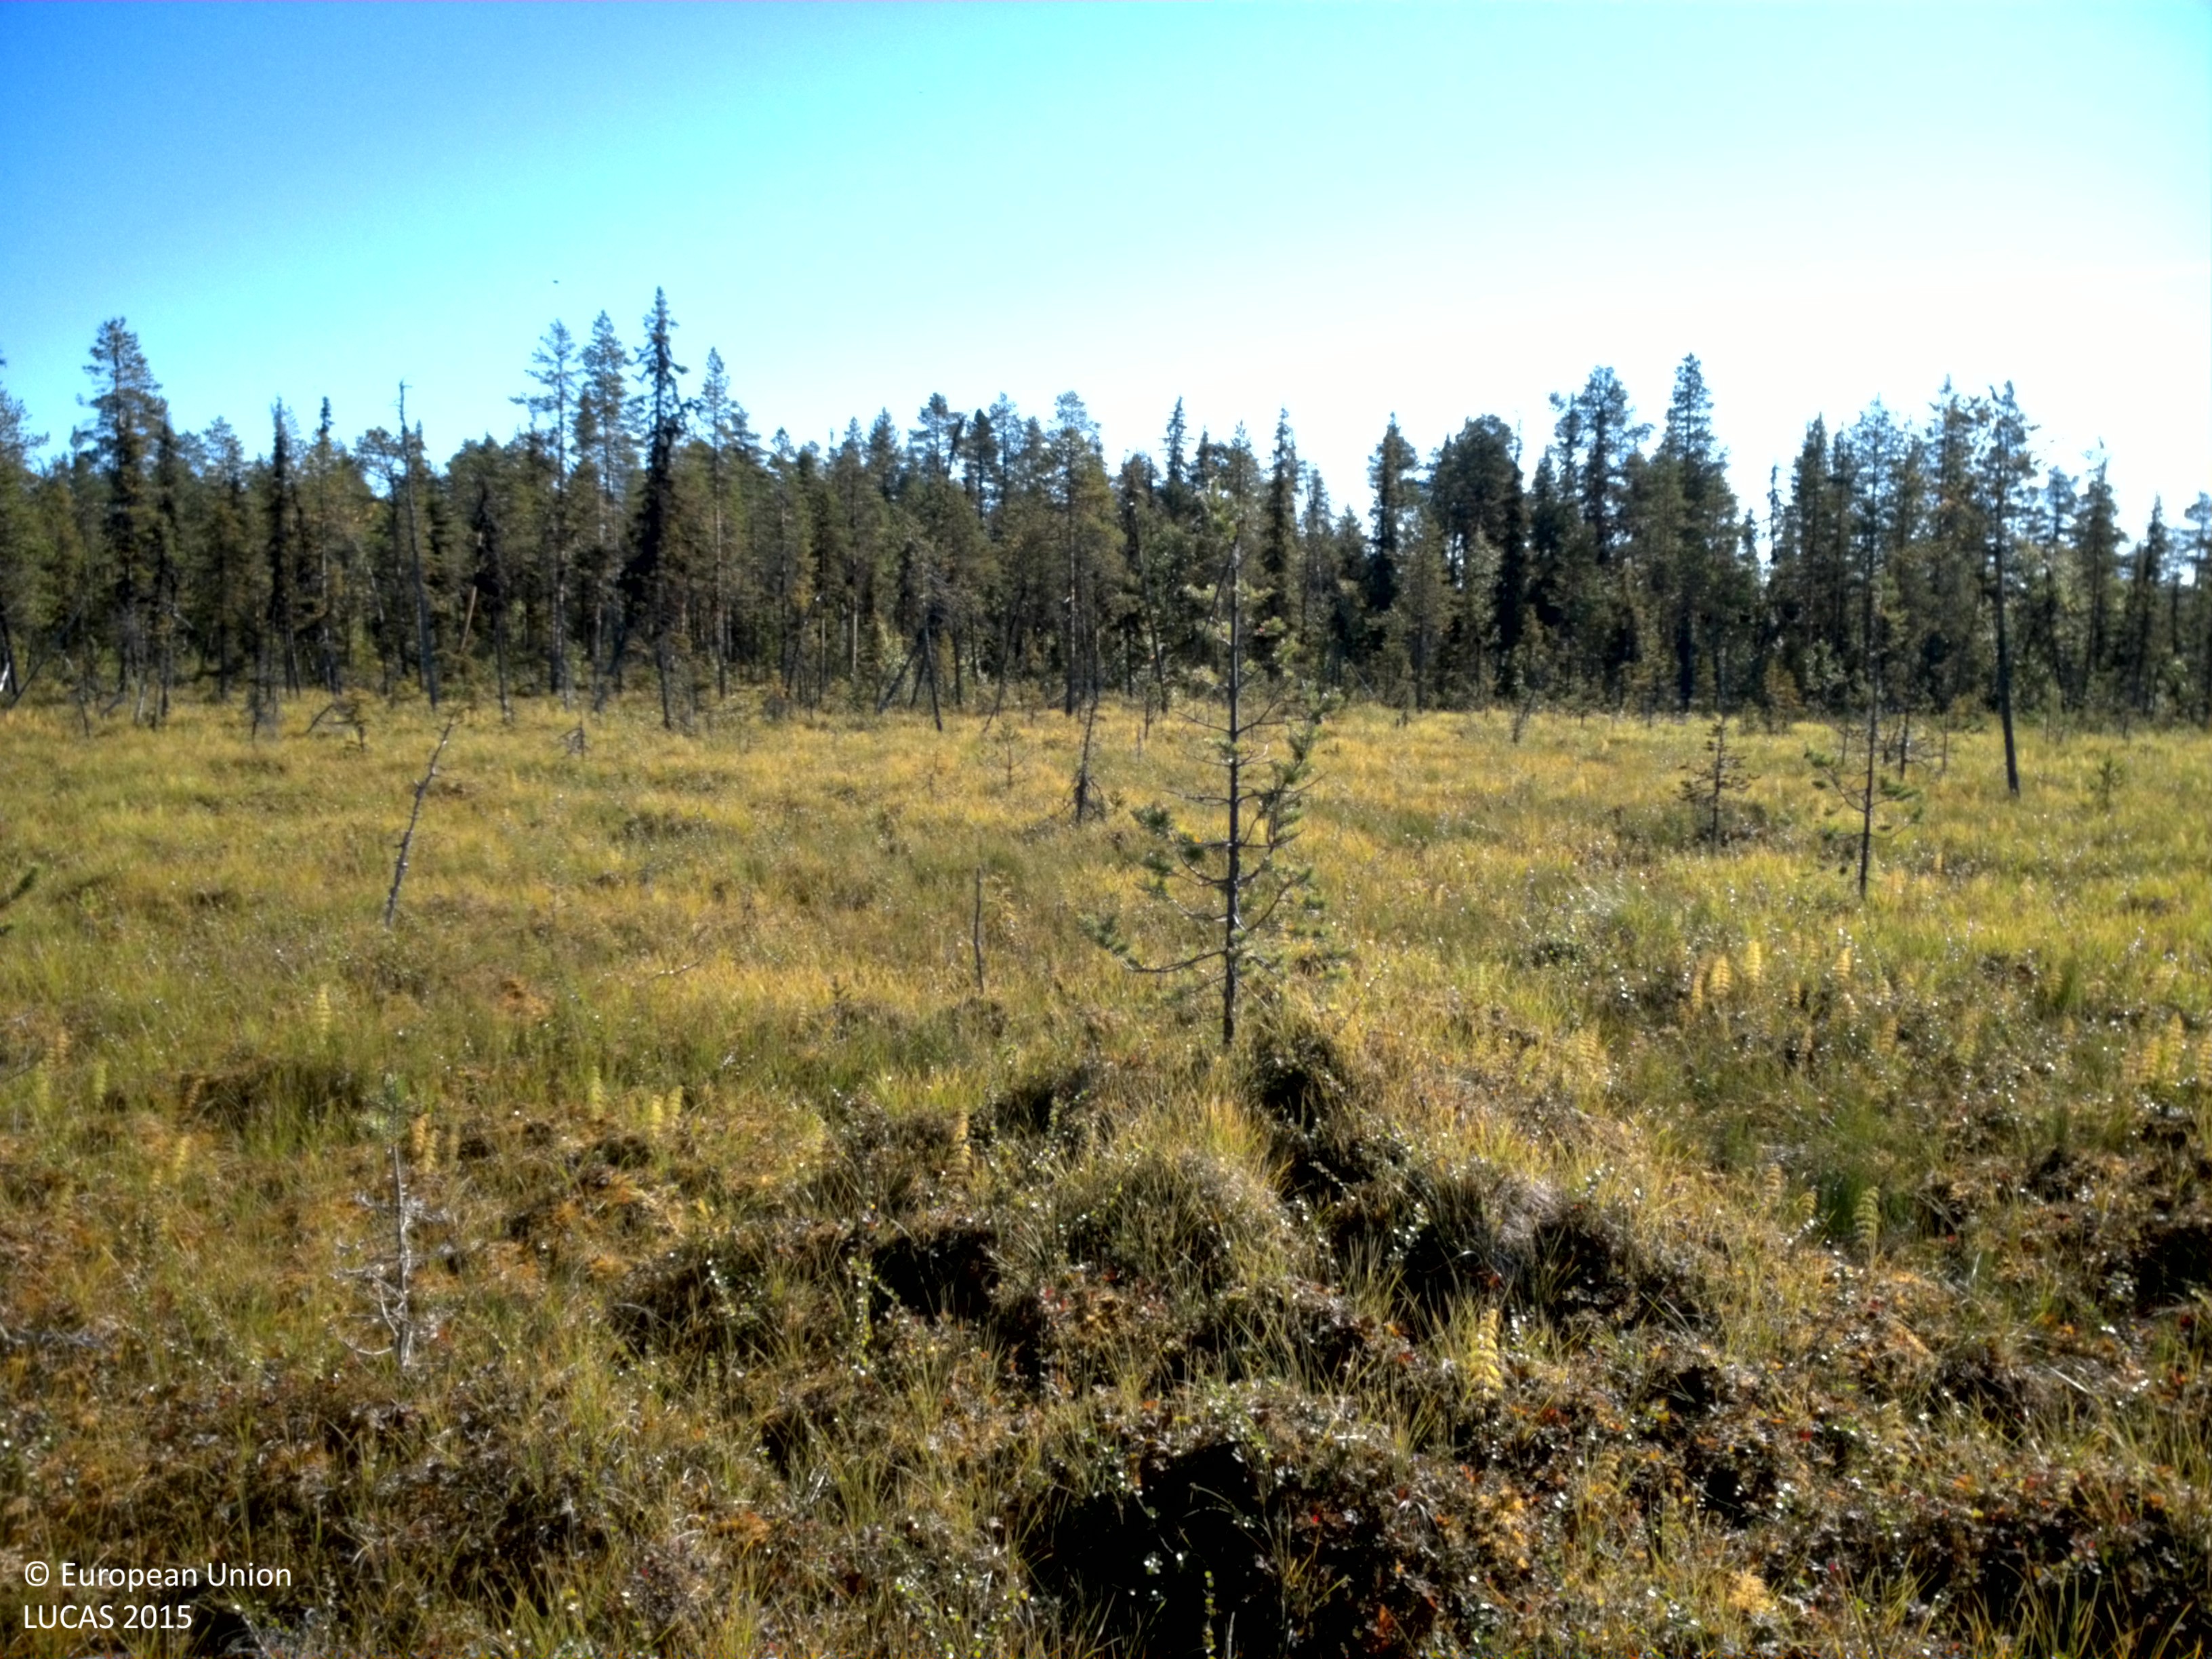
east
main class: Shrubland
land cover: Shrubland with sparse tree cover
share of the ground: 50 - 75 %
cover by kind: shrubs 60 %, herbaceous plants 35 %, coniferous forest trees 5 %
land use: Semi-natural and natural areas not in use
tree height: < 5 m
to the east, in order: Shrubland with sparse tree cover; Peatbogs; Pine dominated coniferous woodland; Other mixed woodland; Pine dominated coniferous woodland; Pine dominated mixed woodland; Peatbogs; Spruce dominated coniferous woodland; Pine dominated coniferous woodland
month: August
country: SE
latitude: 66.7410
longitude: 19.4584
